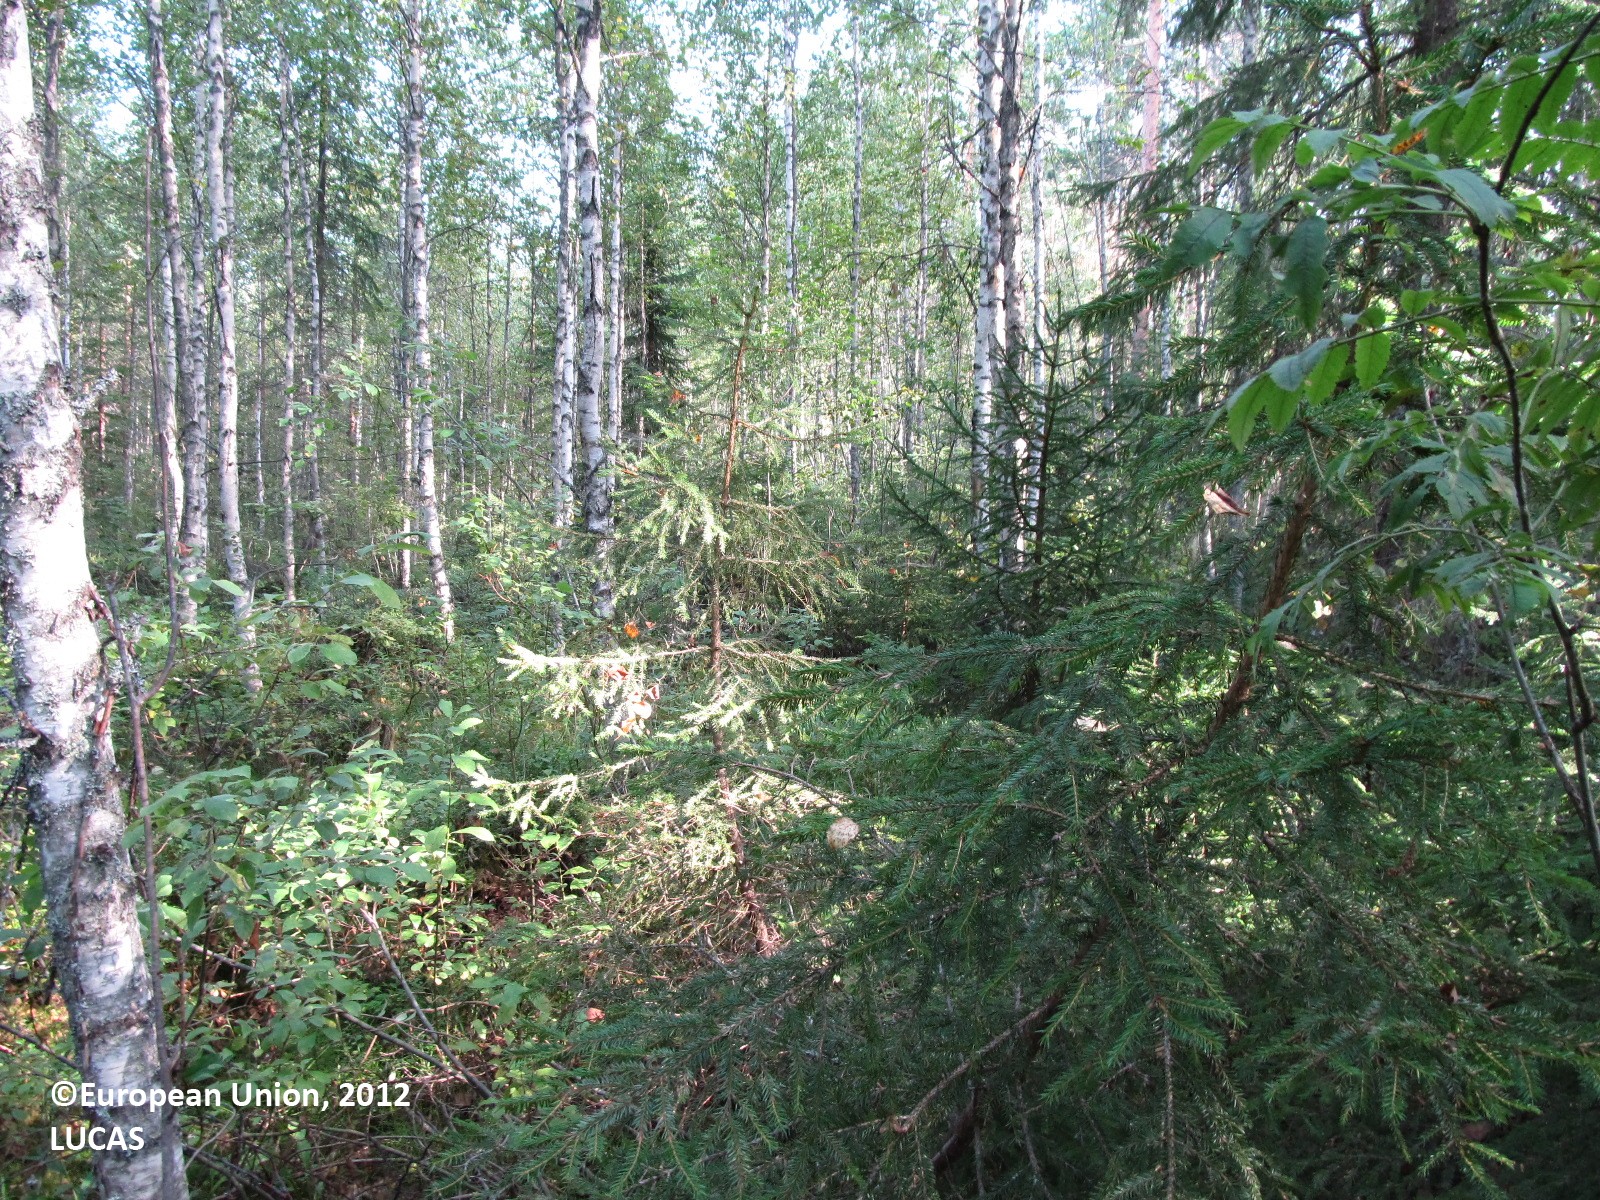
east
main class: Woodland
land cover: Other mixed woodland
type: boreal forest
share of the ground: 50 - 75 %
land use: Forestry
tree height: > 5 m
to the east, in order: Other mixed woodland; Broadleaved woodland; Pine dominated mixed woodland; Shrubland with sparse tree cover; Ditches and canals; Pine dominated mixed woodland; Ditches and canals; Pine dominated mixed woodland; Ditches and canals; Pine dominated mixed woodland
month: August
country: FI
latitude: 62.2618
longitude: 27.8018
